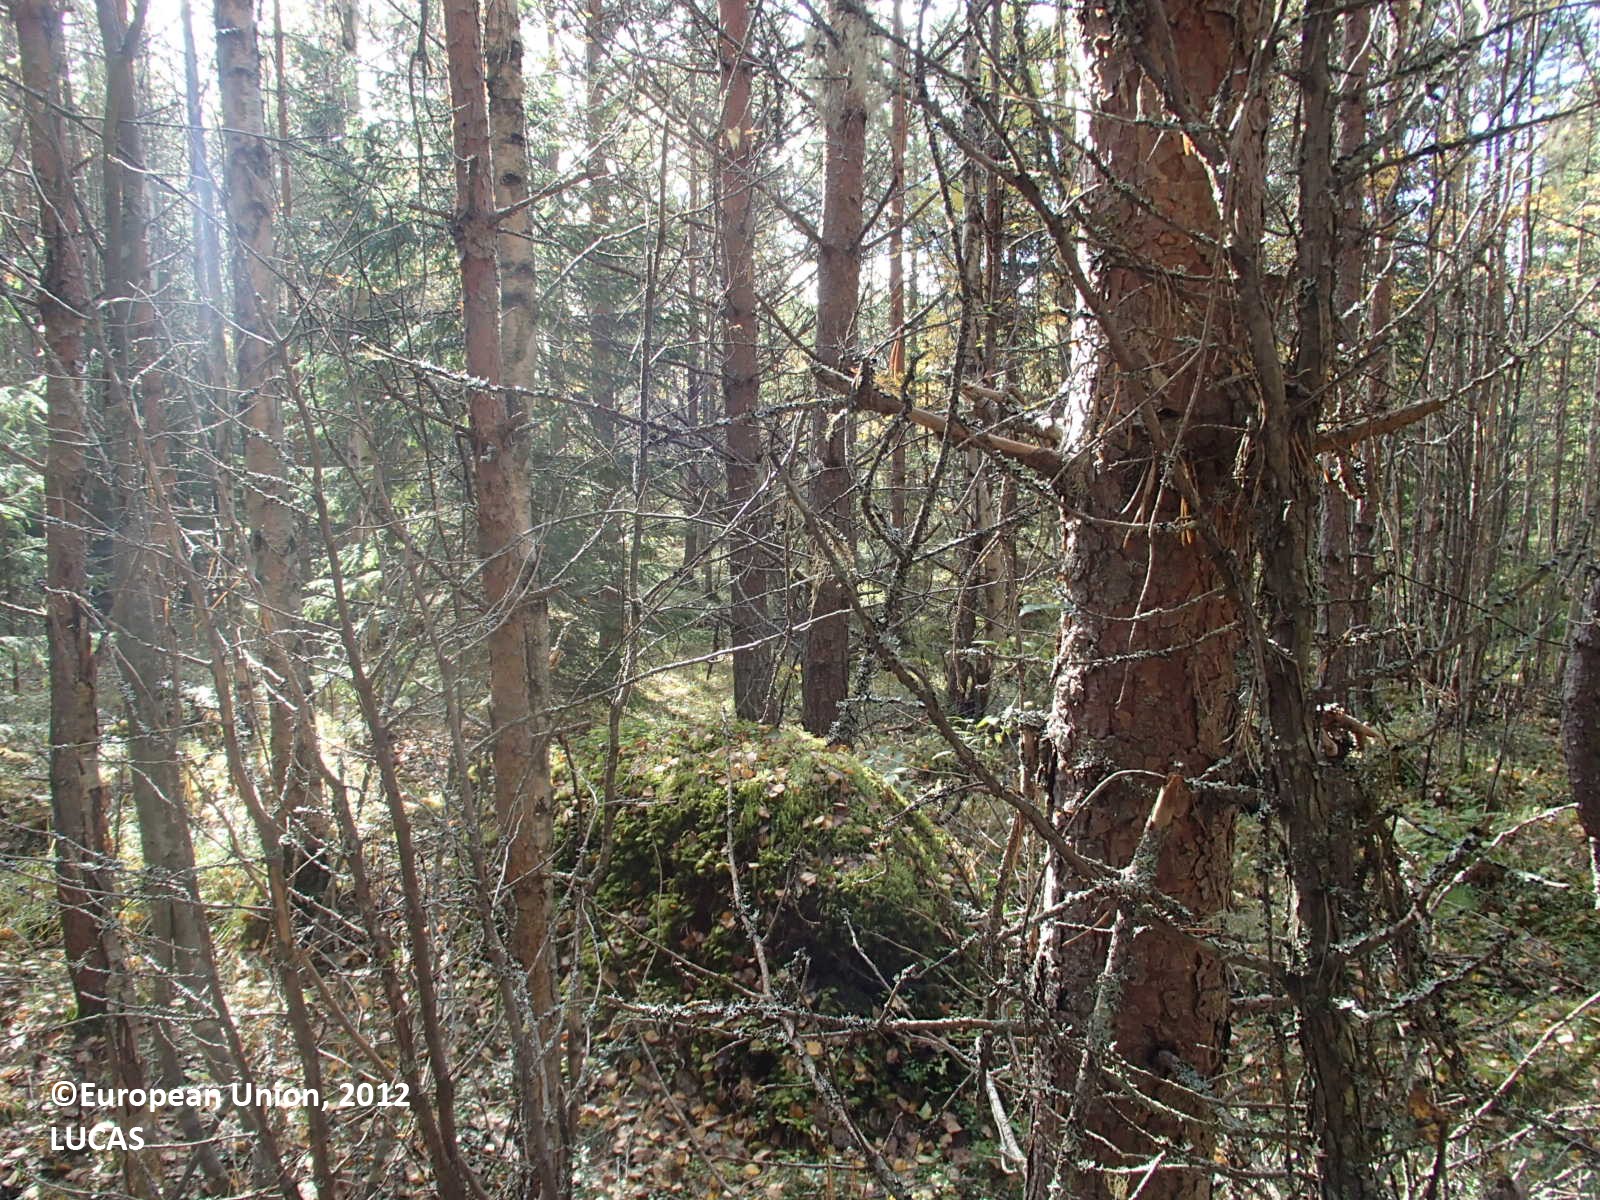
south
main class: Woodland
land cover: Pine dominated mixed woodland
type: boreal forest
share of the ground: > 75 %
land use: Forestry
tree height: > 5 m
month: September
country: FI
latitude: 63.3968
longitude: 27.8005
